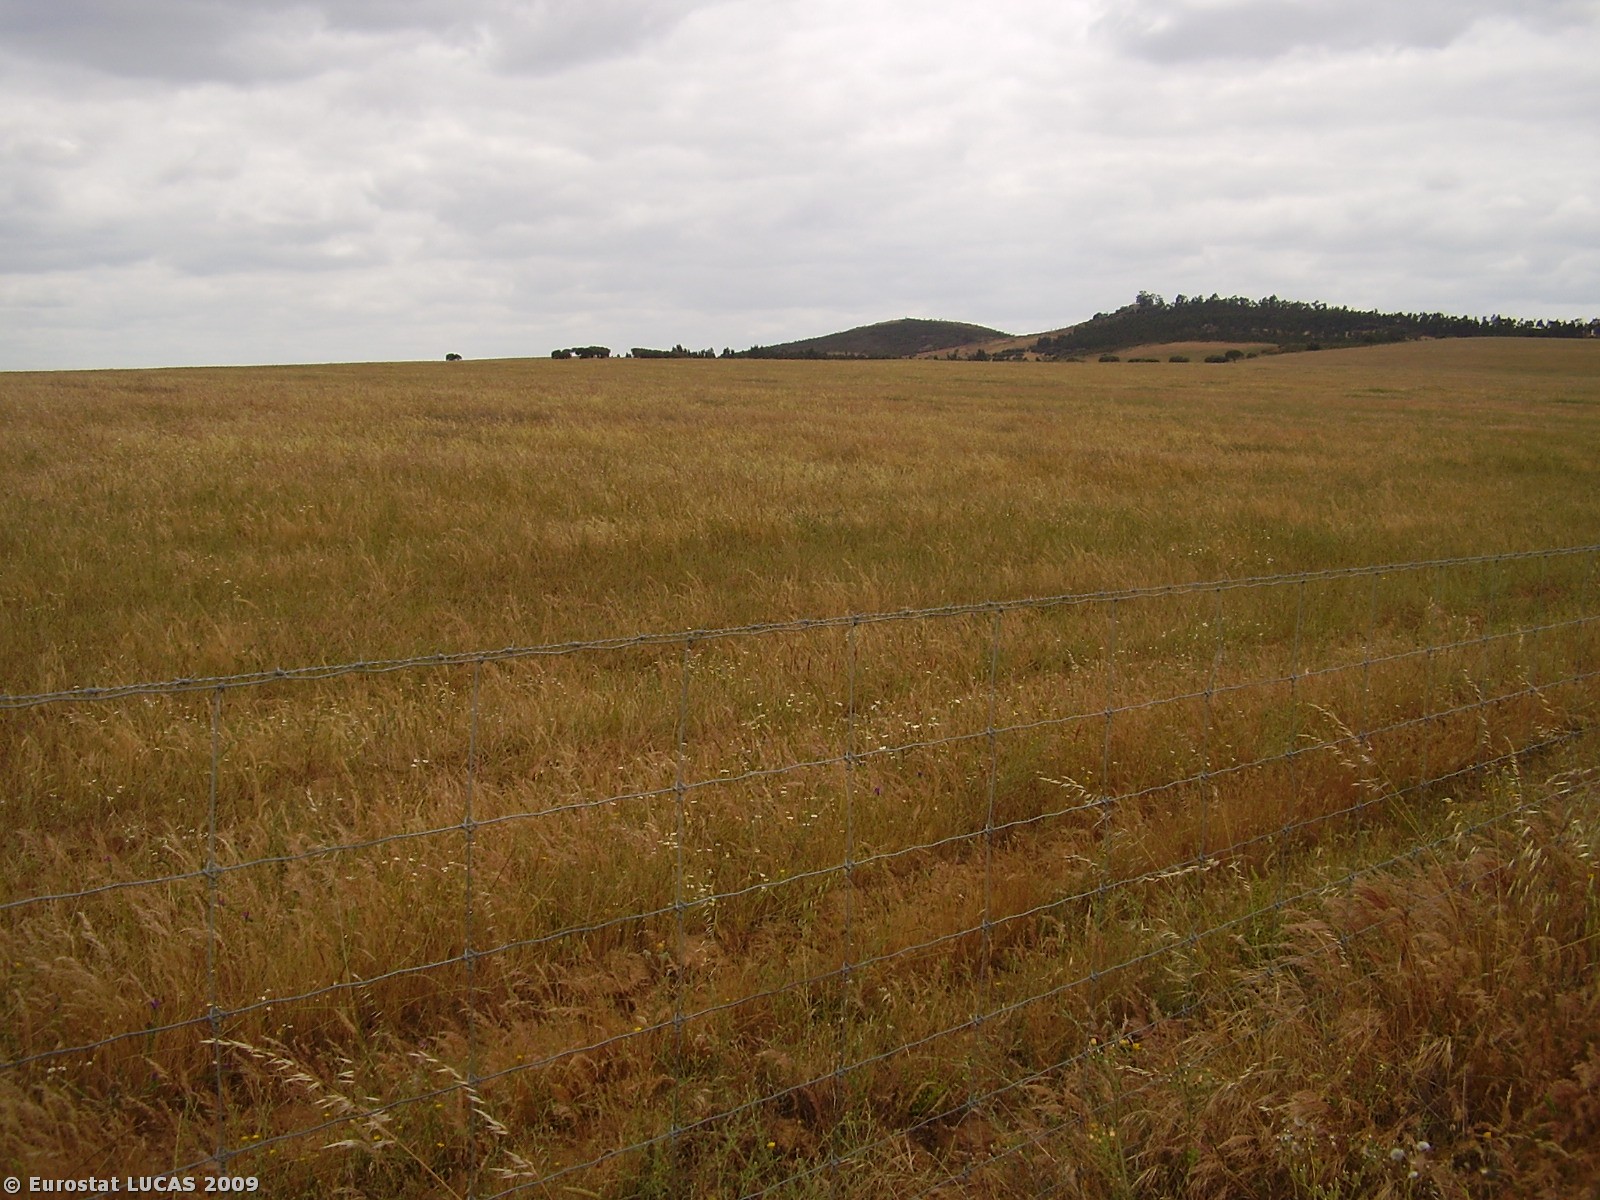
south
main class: Grassland
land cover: Grassland without tree/shrub cover
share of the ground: > 75 %
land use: Agriculture (excluding fallow land and kitchen gardens)
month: May
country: PT
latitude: 37.7596
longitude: -7.8780
